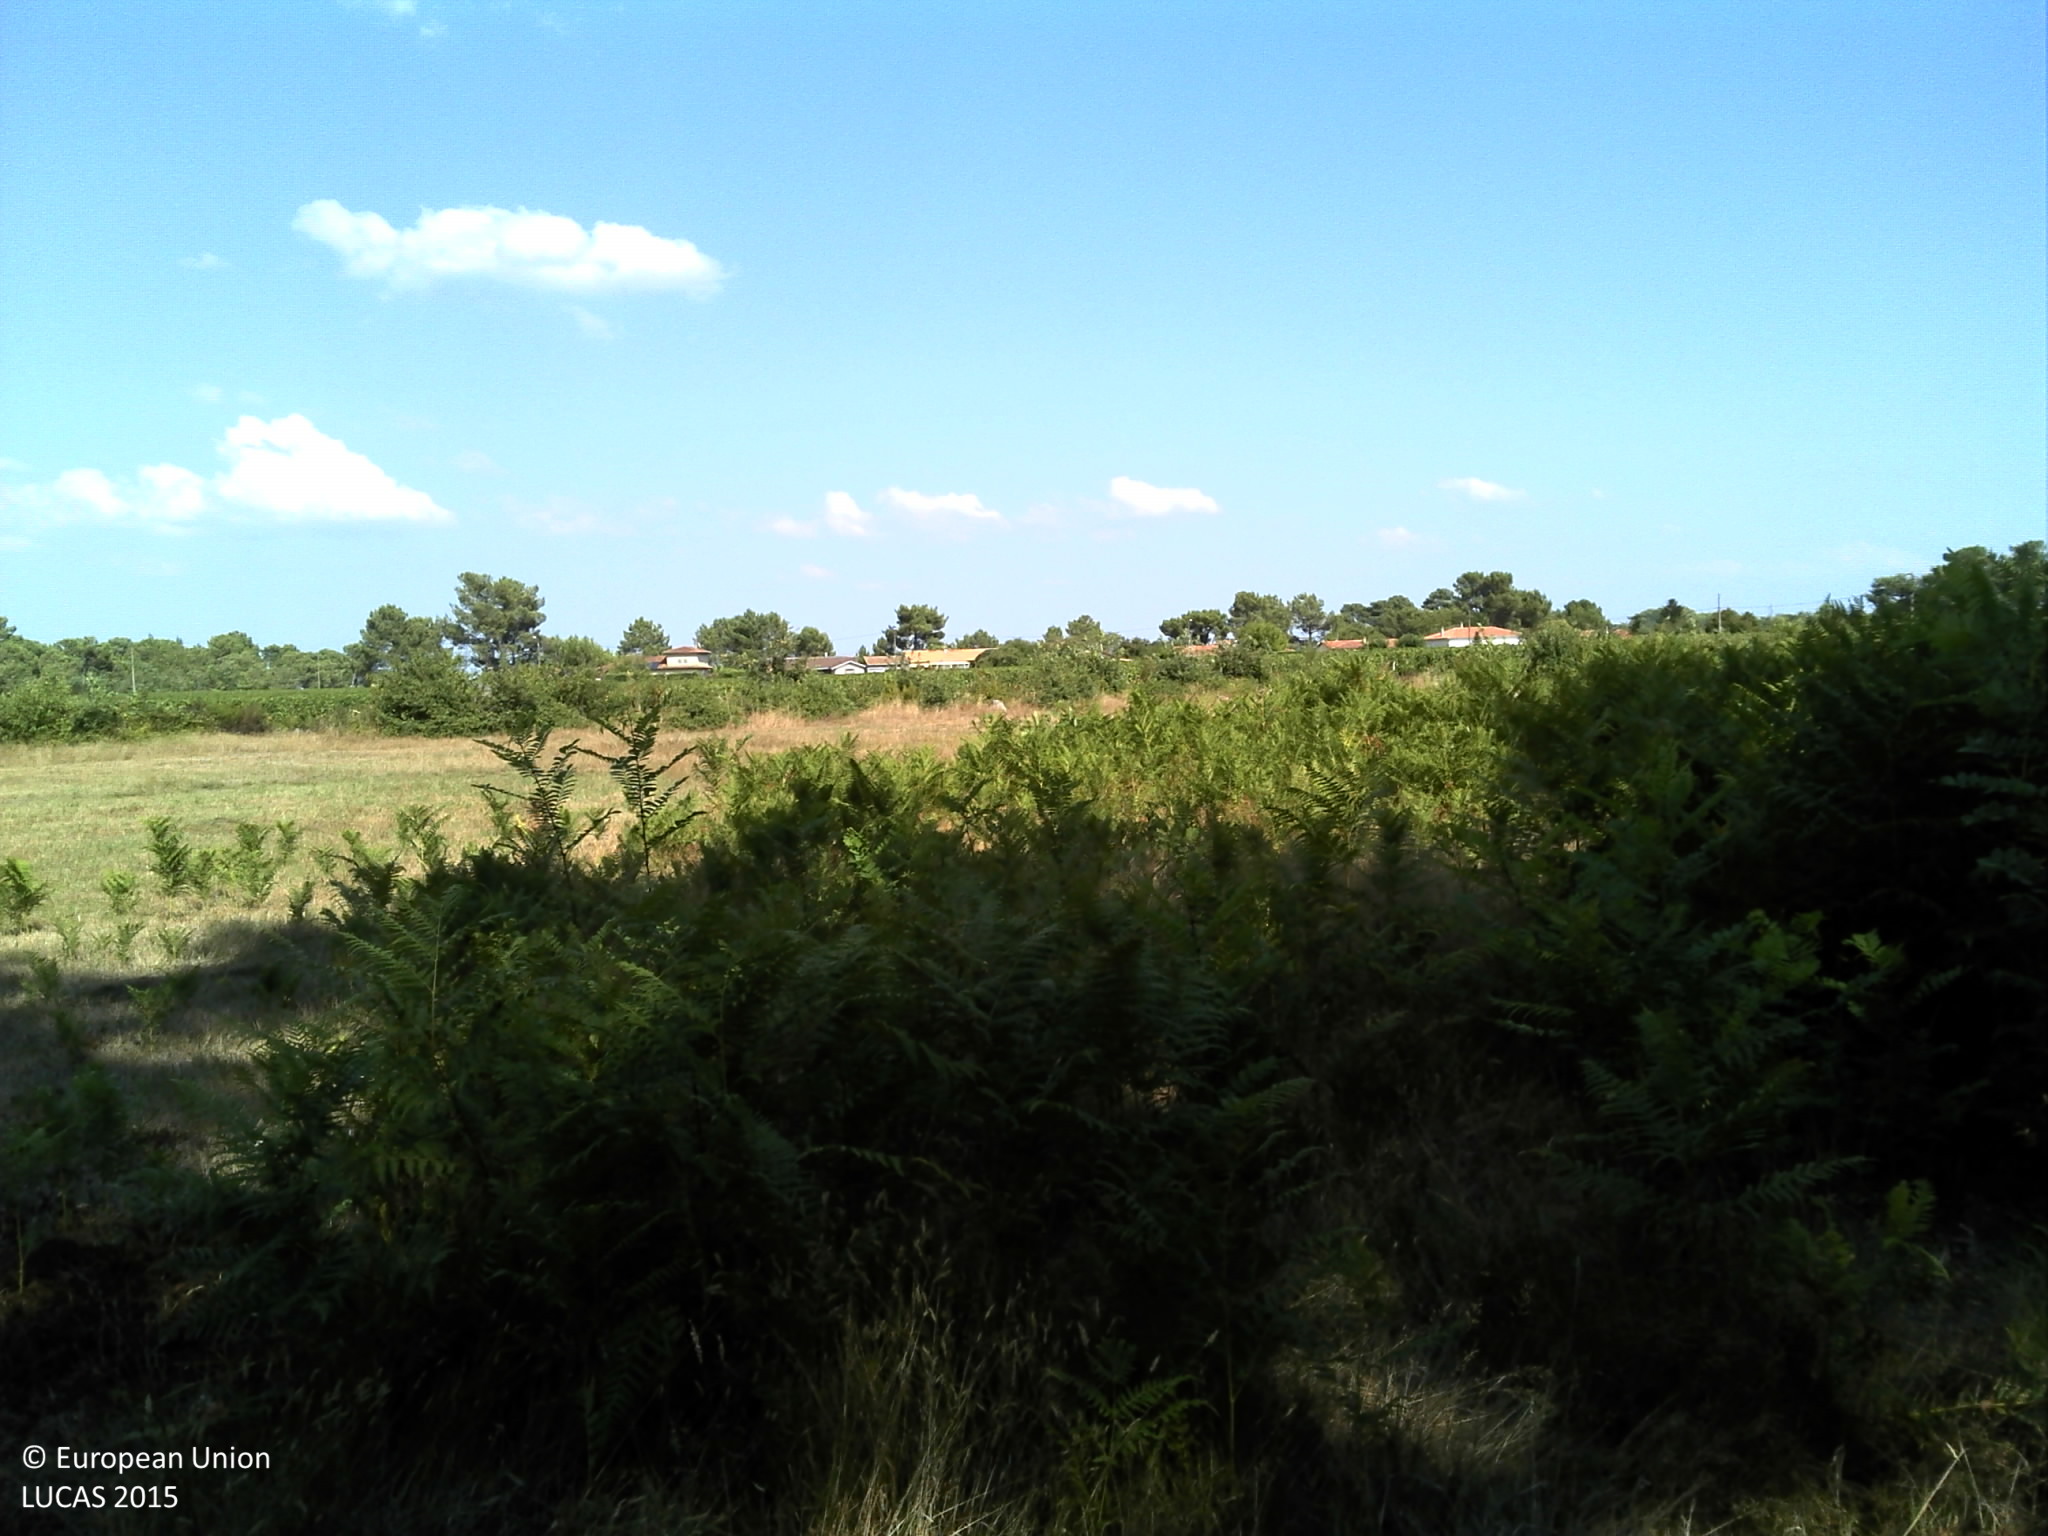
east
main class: Grassland
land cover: Spontaneously vegetated surfaces
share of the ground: > 75 %
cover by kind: herbaceous plants 95 %, shrubs 5 %
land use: Semi-natural and natural areas not in use
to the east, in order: Spontaneously vegetated surfaces; Tracks; Spontaneously vegetated surfaces; Grassland without tree/shrub cover; Tracks; Grassland without tree/shrub cover; Shrubland with sparse tree cover; Fences; Ditches and canals; Grassland without tree/shrub cover; Vineyards; Tracks; Vineyards
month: August
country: FR
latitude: 44.9839
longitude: -0.6350
